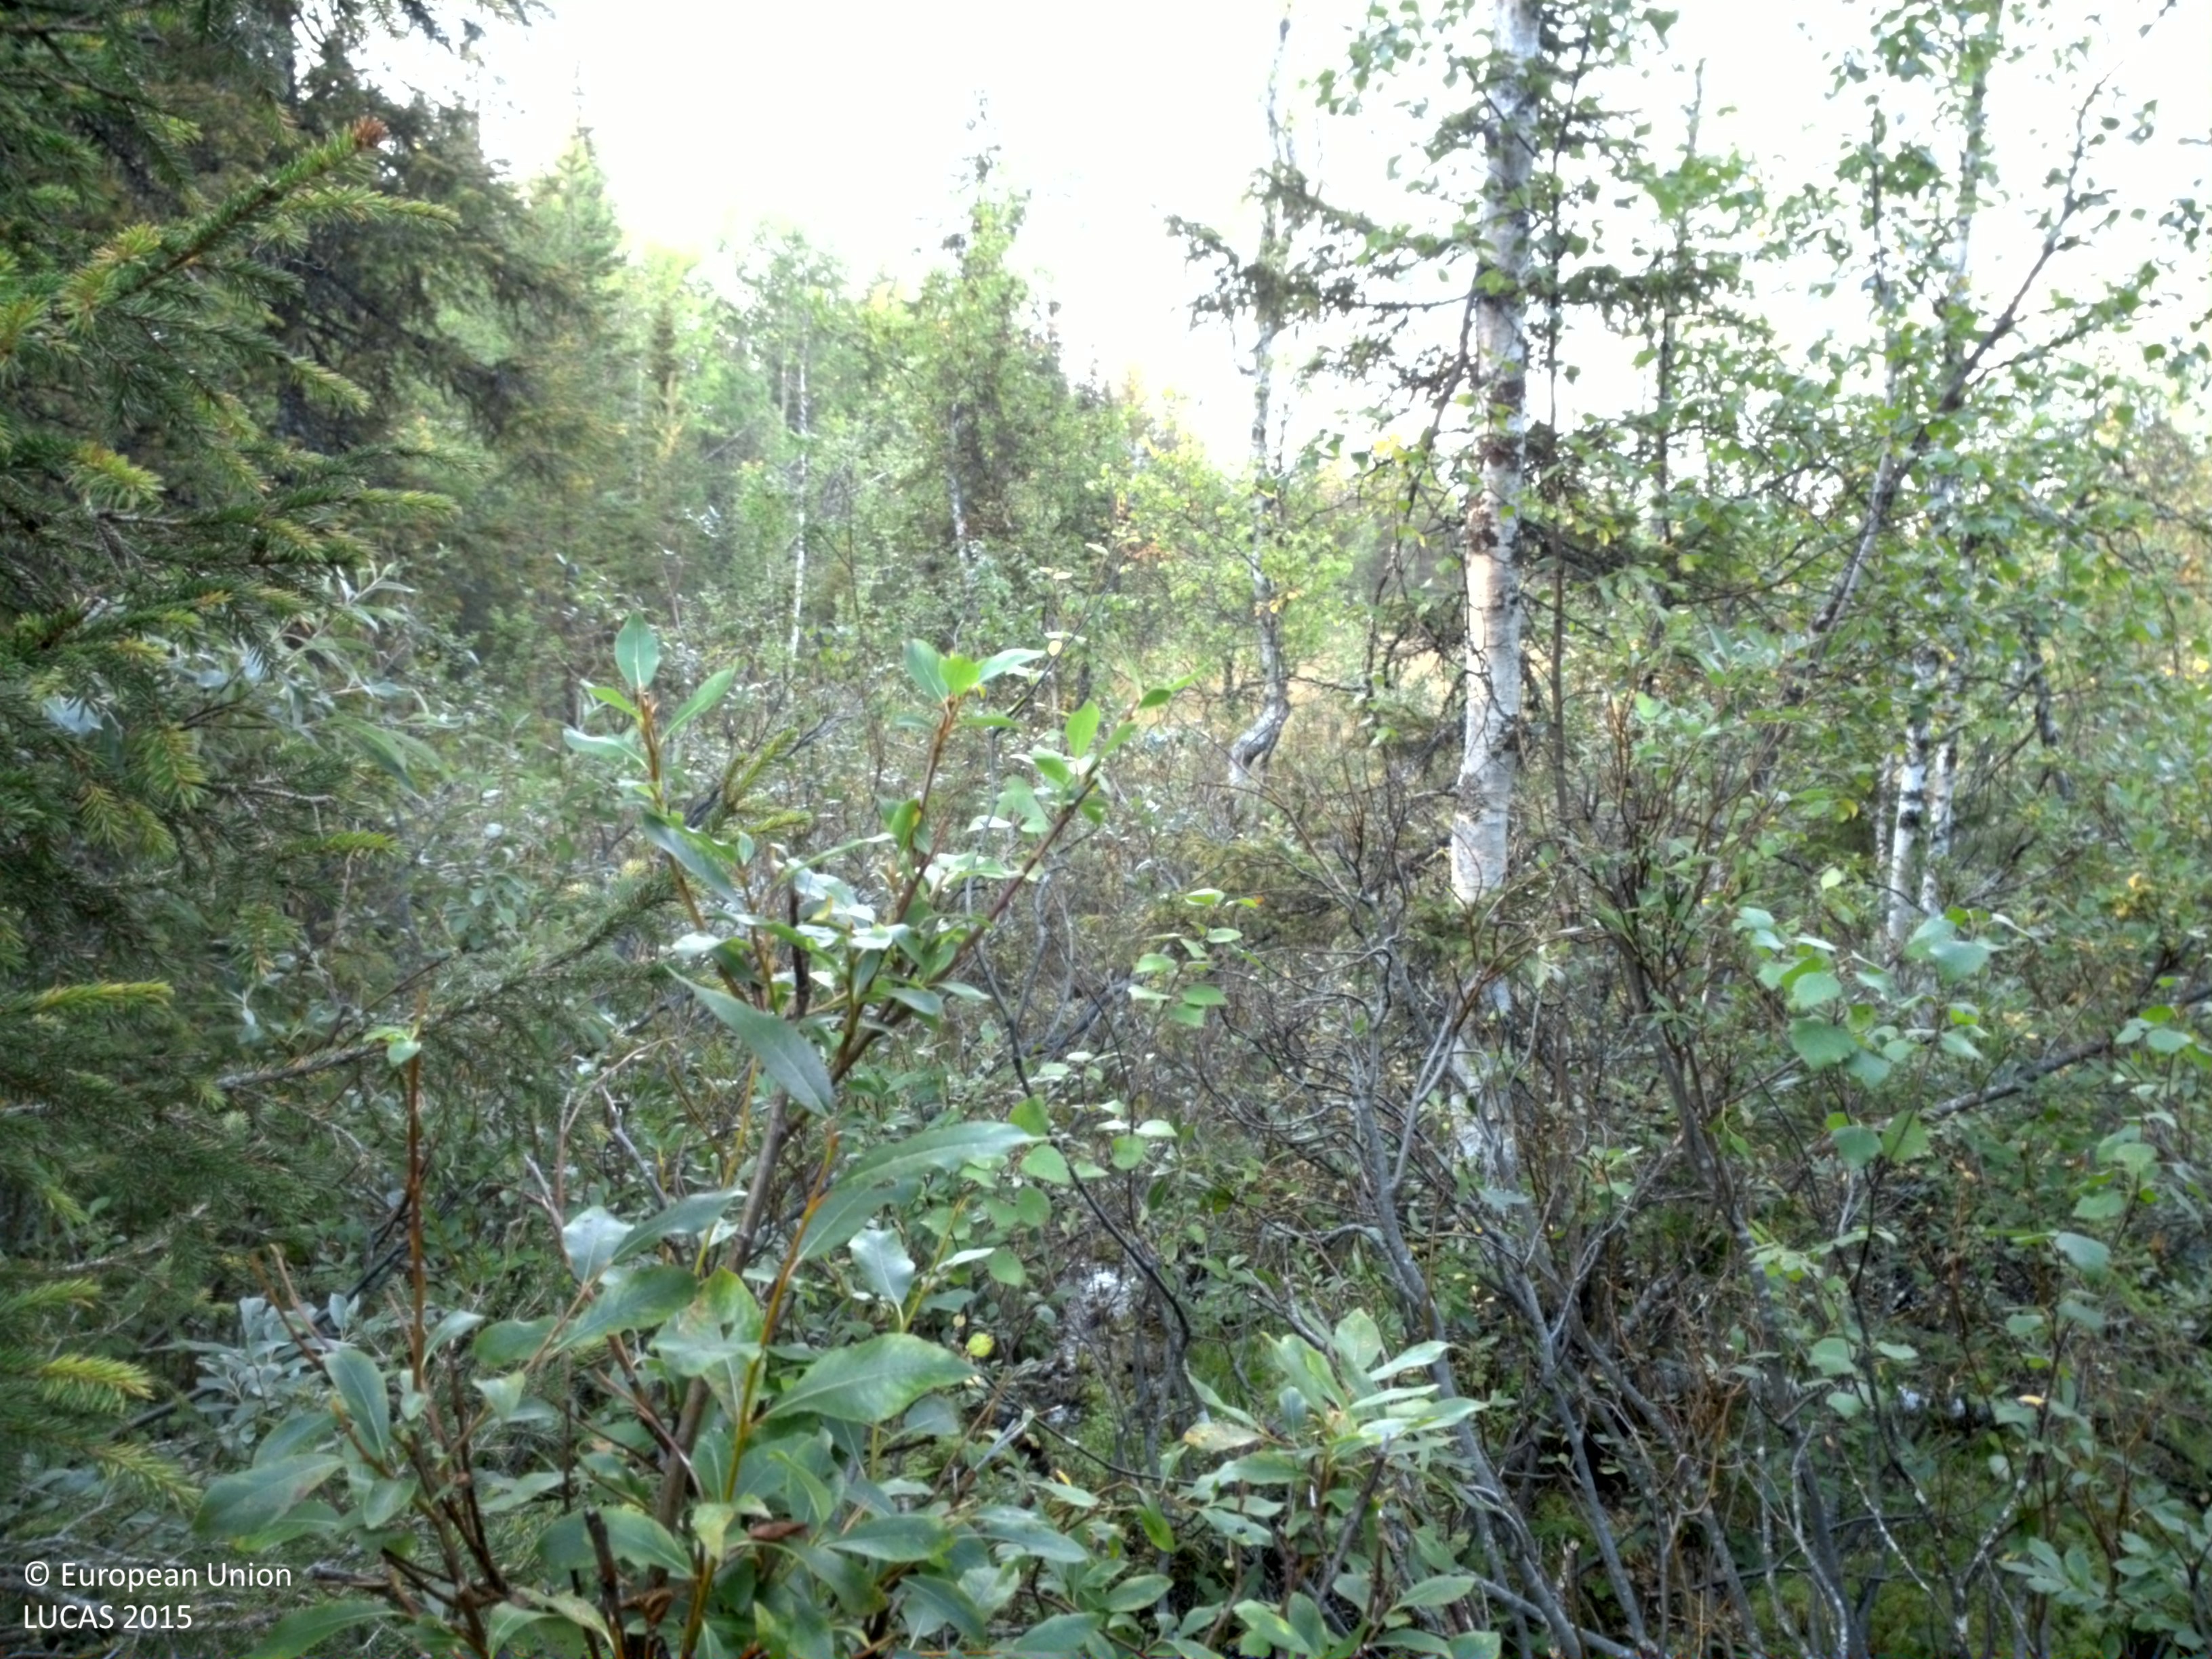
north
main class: Woodland
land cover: Spruce dominated mixed woodland
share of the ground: 25 - 50 %
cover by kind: shrubs 40 %, broadleaved forest trees 25 %, coniferous forest trees 20 %, lichens and mosses 10 %
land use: Forestry
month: August
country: SE
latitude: 66.6086
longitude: 20.7685
